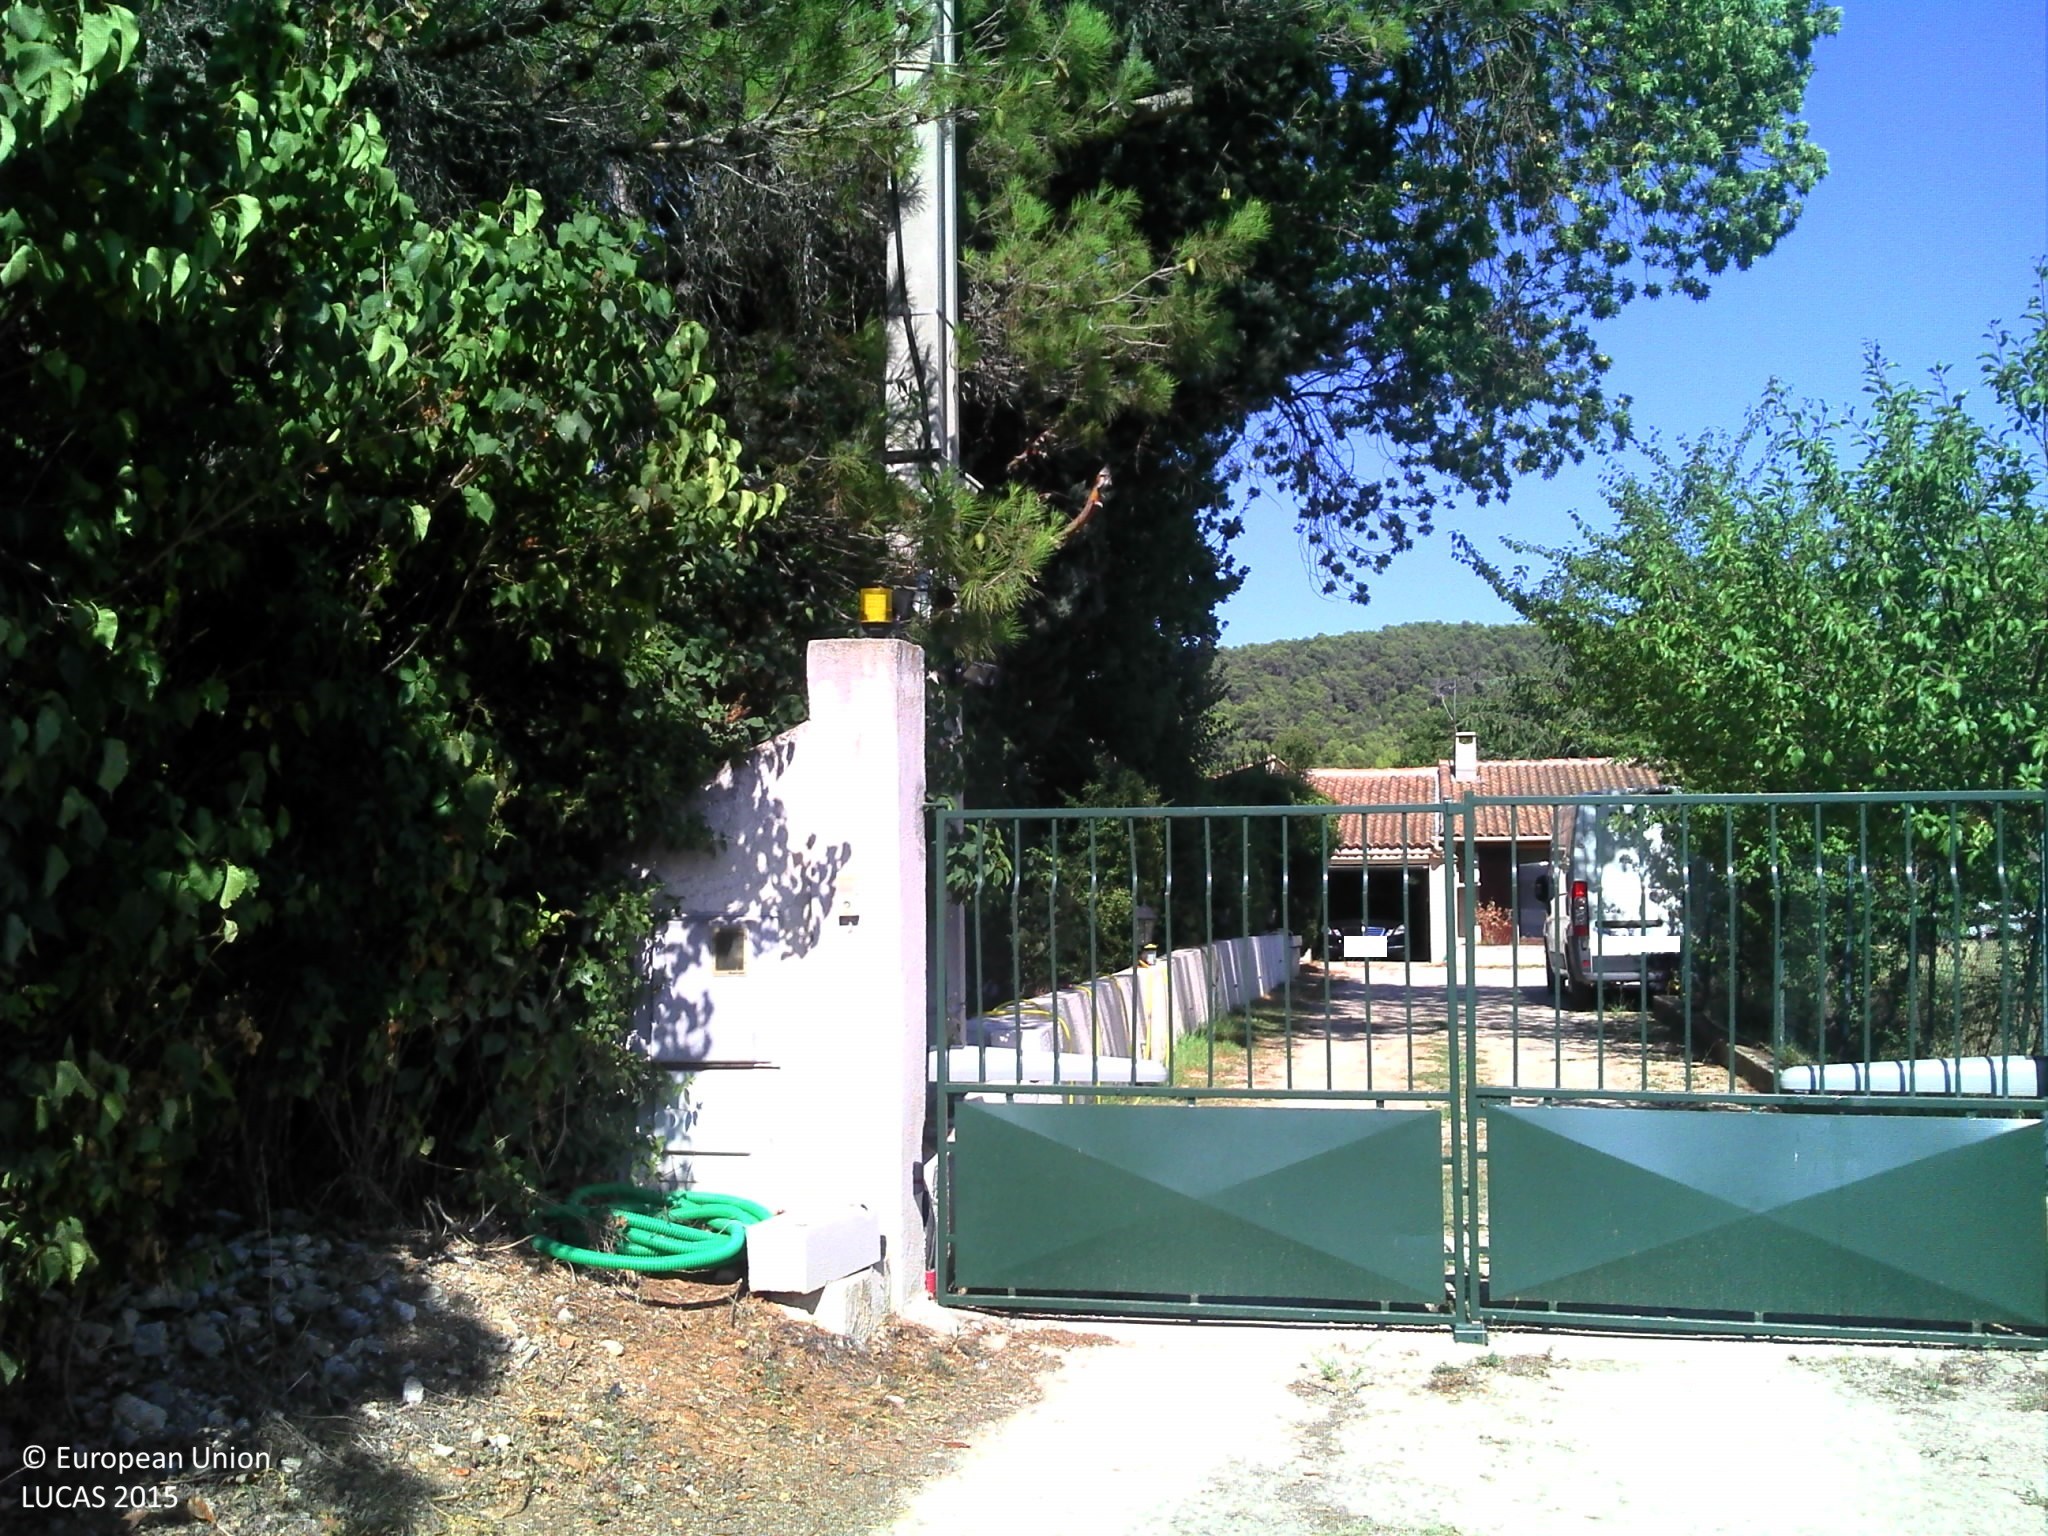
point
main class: Woodland
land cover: Broadleaved woodland
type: thermophilous deciduous forest
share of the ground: > 75 %
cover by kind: broadleaved forest trees 70 %, herbaceous plants 25 %, unconsolidated bare surface 5 %
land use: Residential
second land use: Forestry
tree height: > 5 m
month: August
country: FR
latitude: 43.3902
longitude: 5.6027
